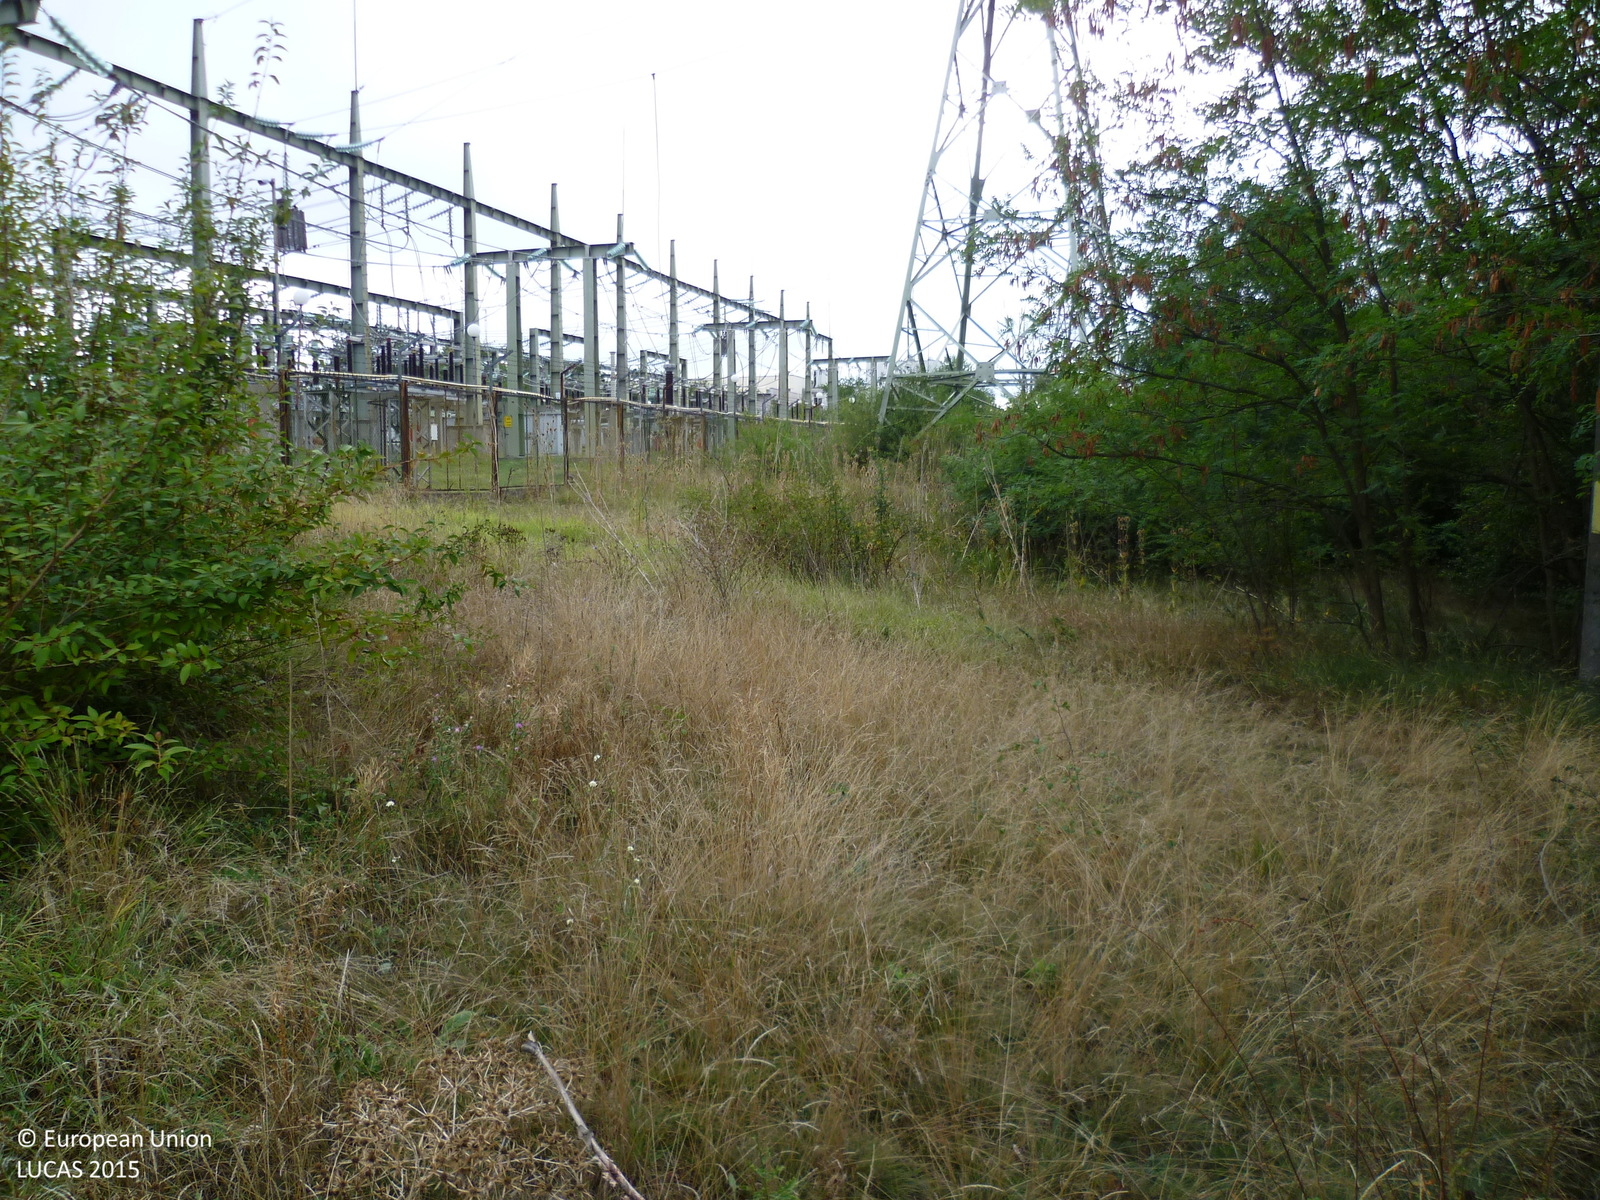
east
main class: Grassland
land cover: Grassland with sparse tree/shrub cover
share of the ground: > 75 %
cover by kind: herbaceous plants 85 %, shrubs 10 %, broadleaved forest trees 5 %
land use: Fallow land
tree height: > 5 m
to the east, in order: Grassland with sparse tree/shrub cover; Artificial constructions in urban areas
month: September
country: BG
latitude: 42.8472
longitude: 23.1880
